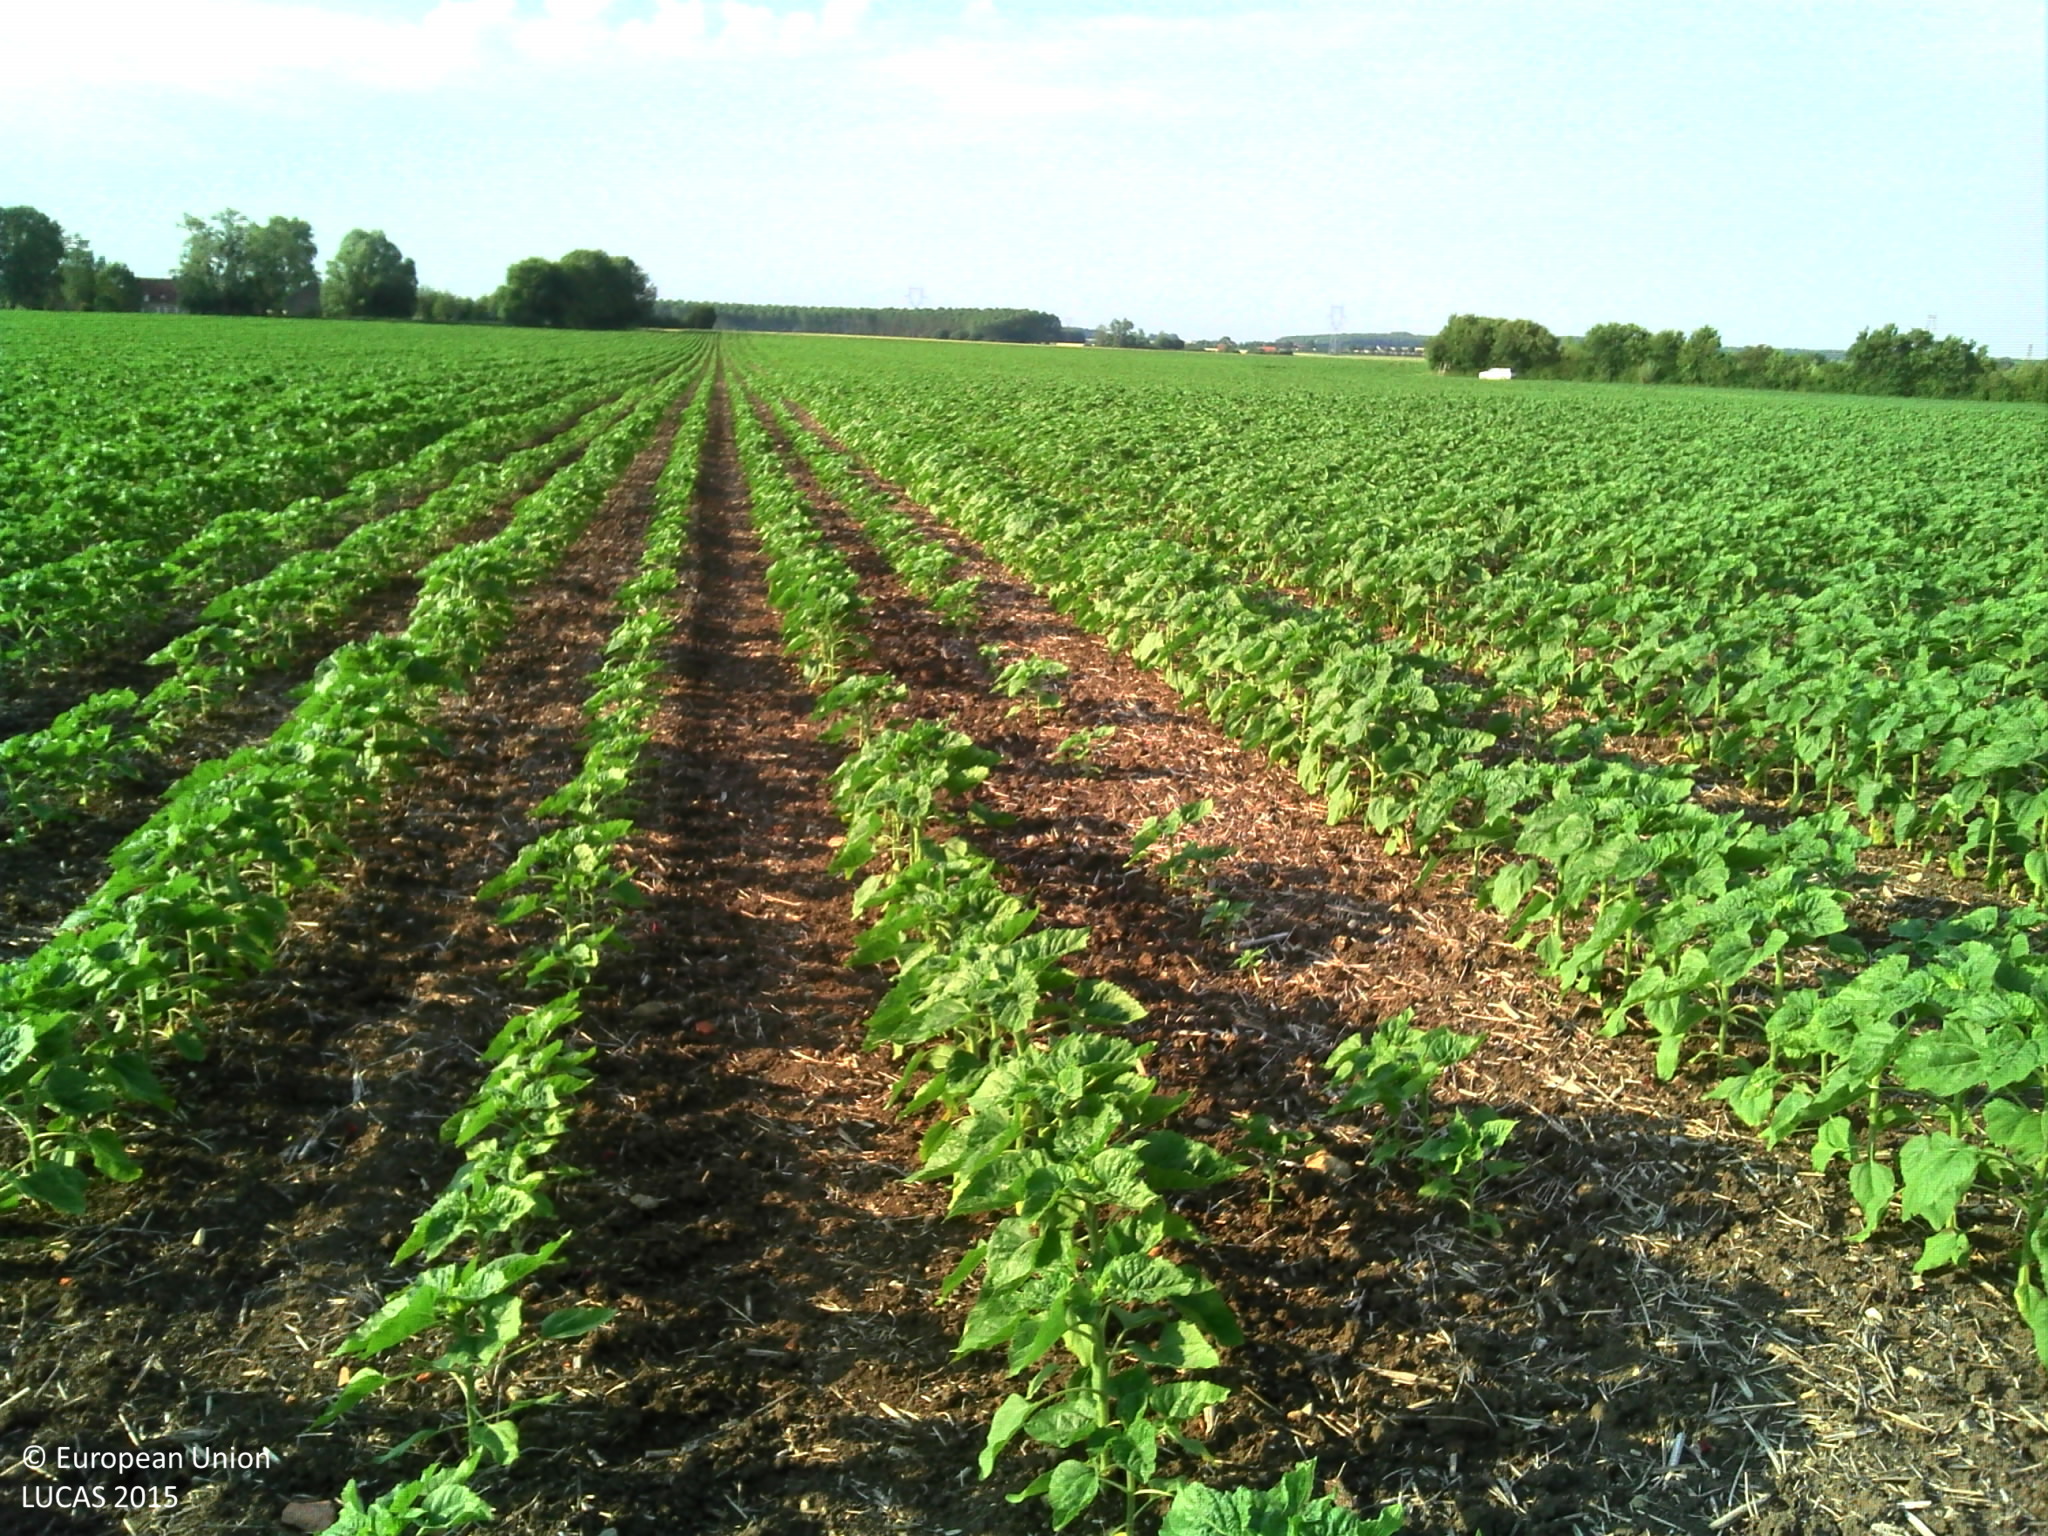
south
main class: Cropland
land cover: Sunflower
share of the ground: > 75 %
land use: Agriculture (excluding fallow land and kitchen gardens)
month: June
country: FR
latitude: 46.8763
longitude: 2.6600
